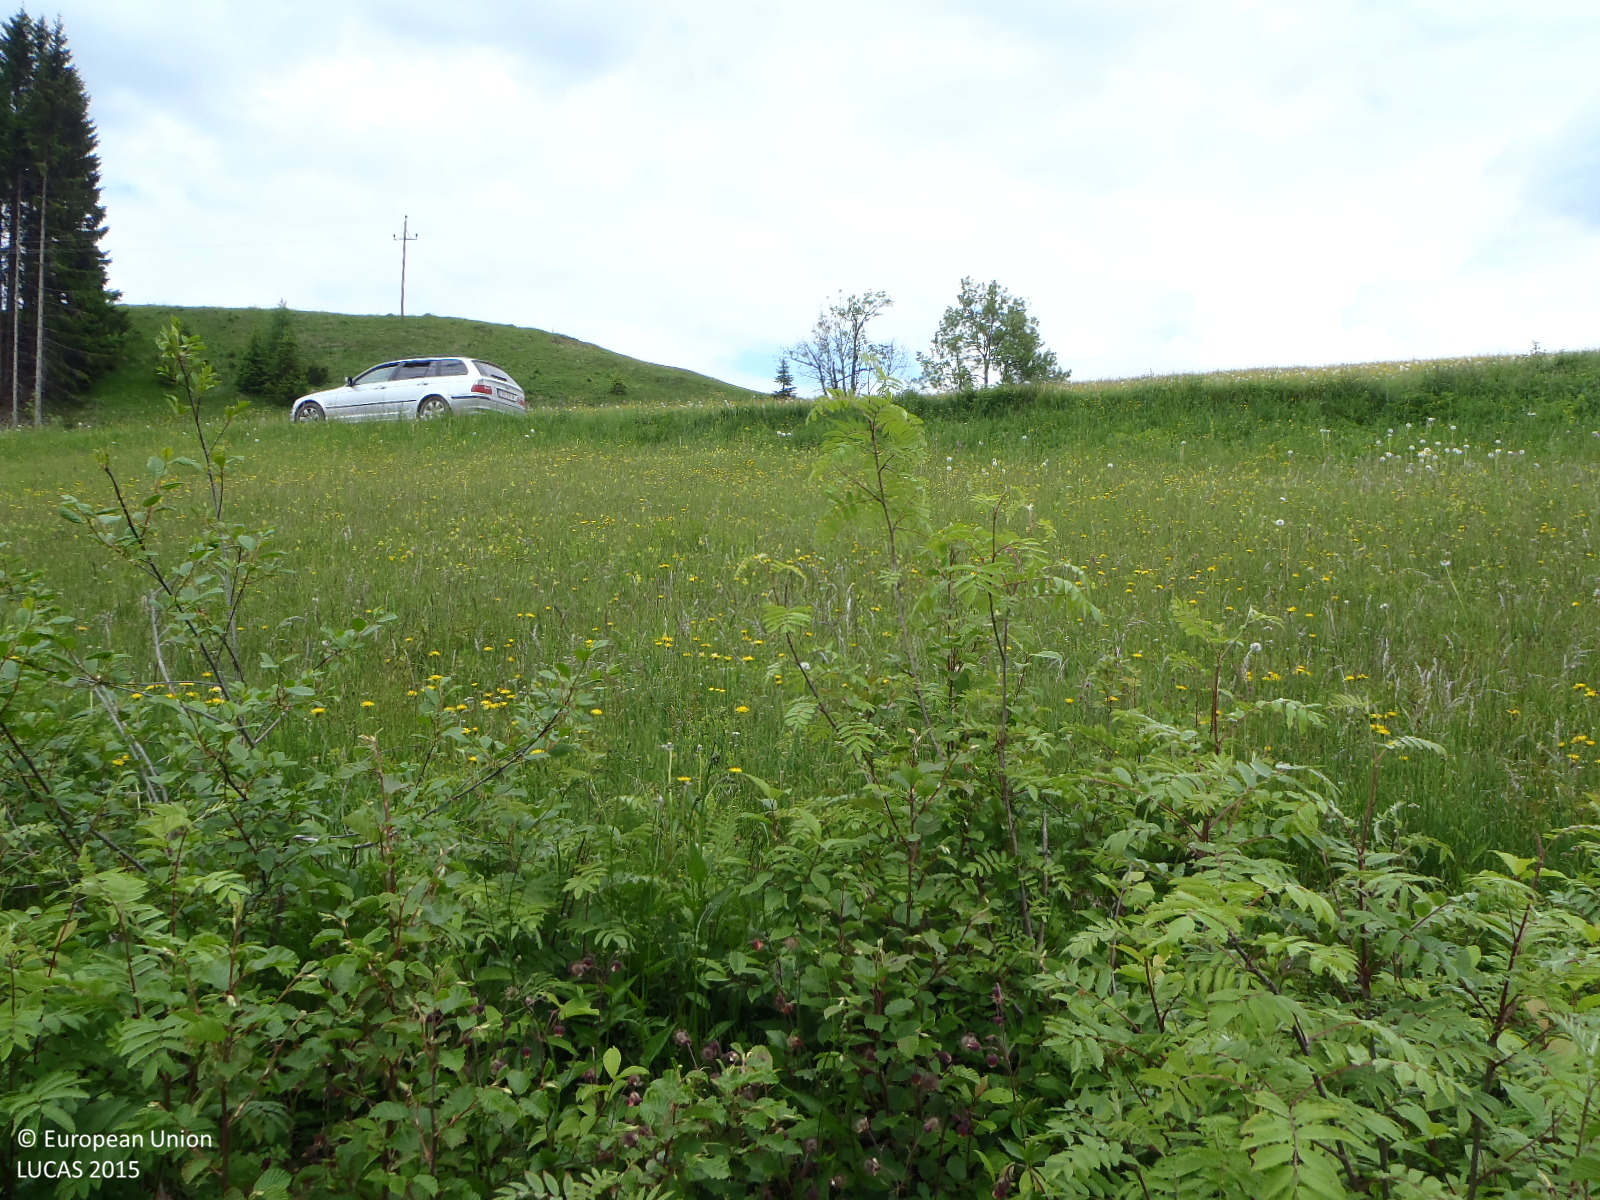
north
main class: Shrubland
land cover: Shrubland with sparse tree cover
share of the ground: > 75 %
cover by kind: shrubs 90 %, broadleaved forest trees 5 %, herbaceous plants 5 %
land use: Forestry
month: June
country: AT
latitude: 47.3751
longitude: 13.5079
